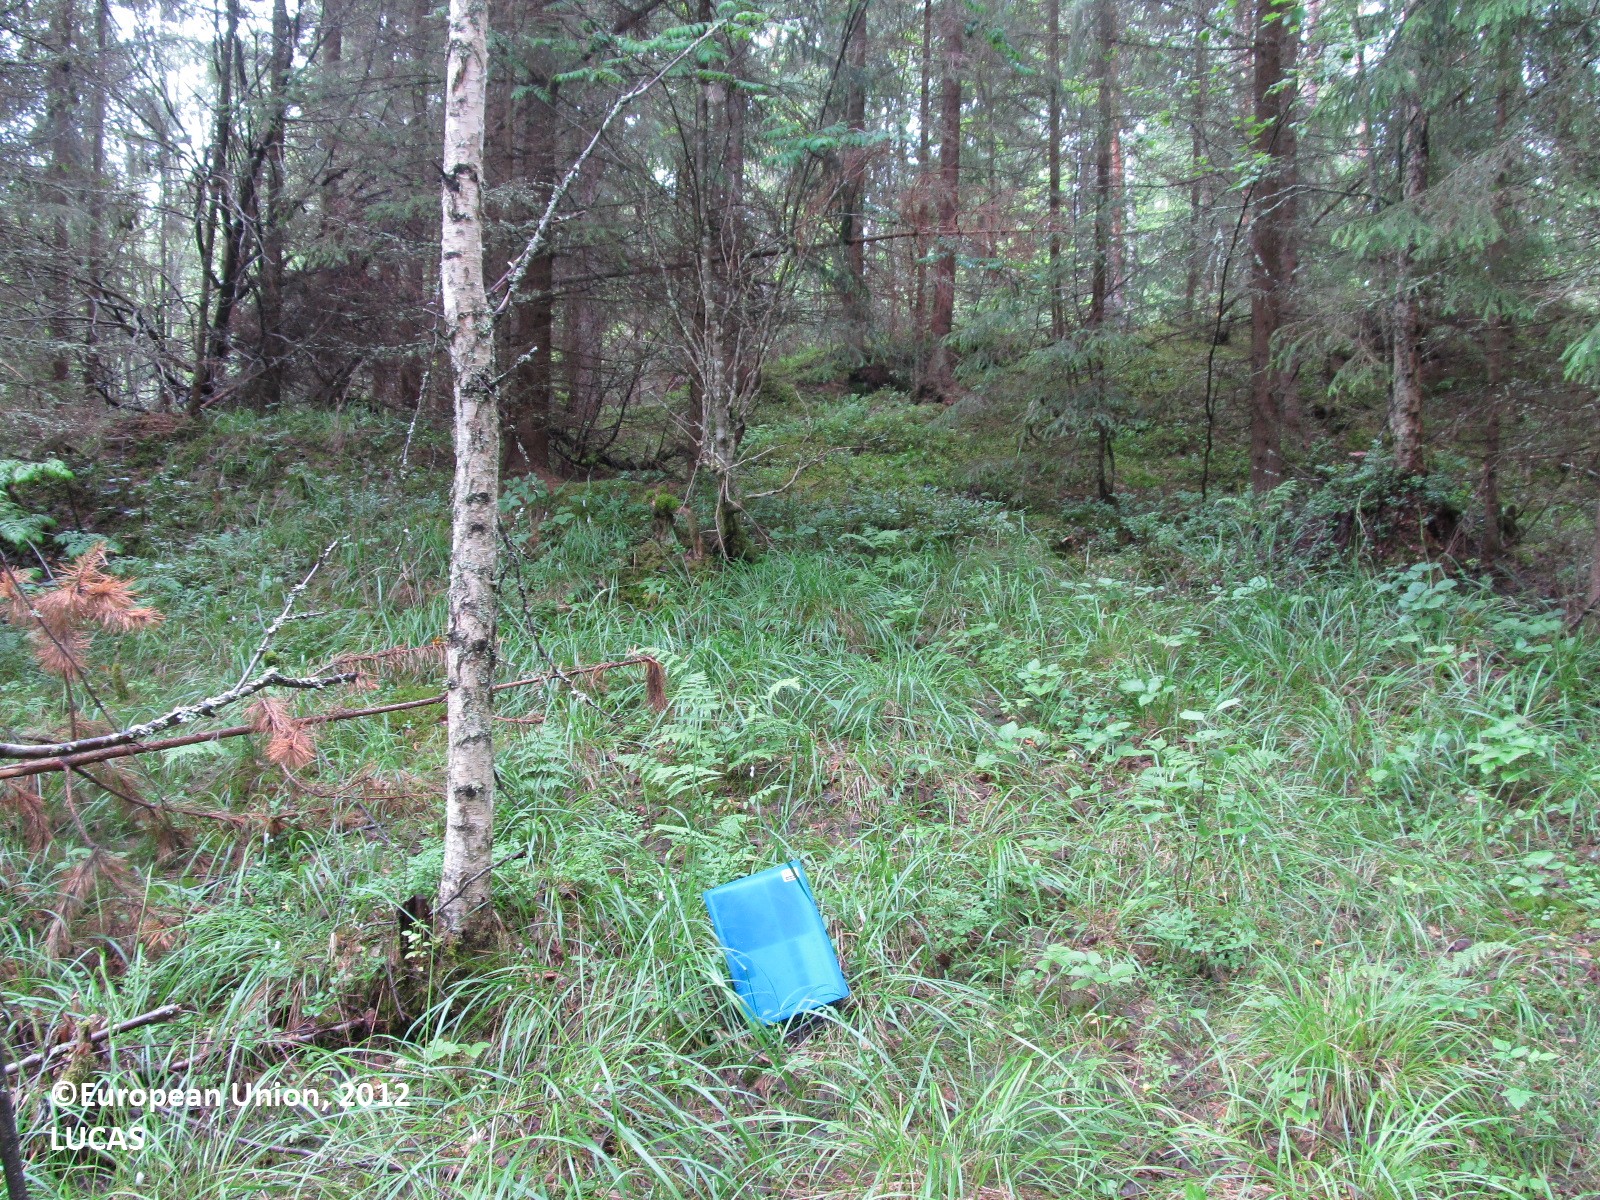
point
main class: Woodland
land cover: Spruce dominated mixed woodland
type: boreal forest
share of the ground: 25 - 50 %
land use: Forestry
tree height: > 5 m
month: July
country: FI
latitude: 61.8618
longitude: 28.4737
